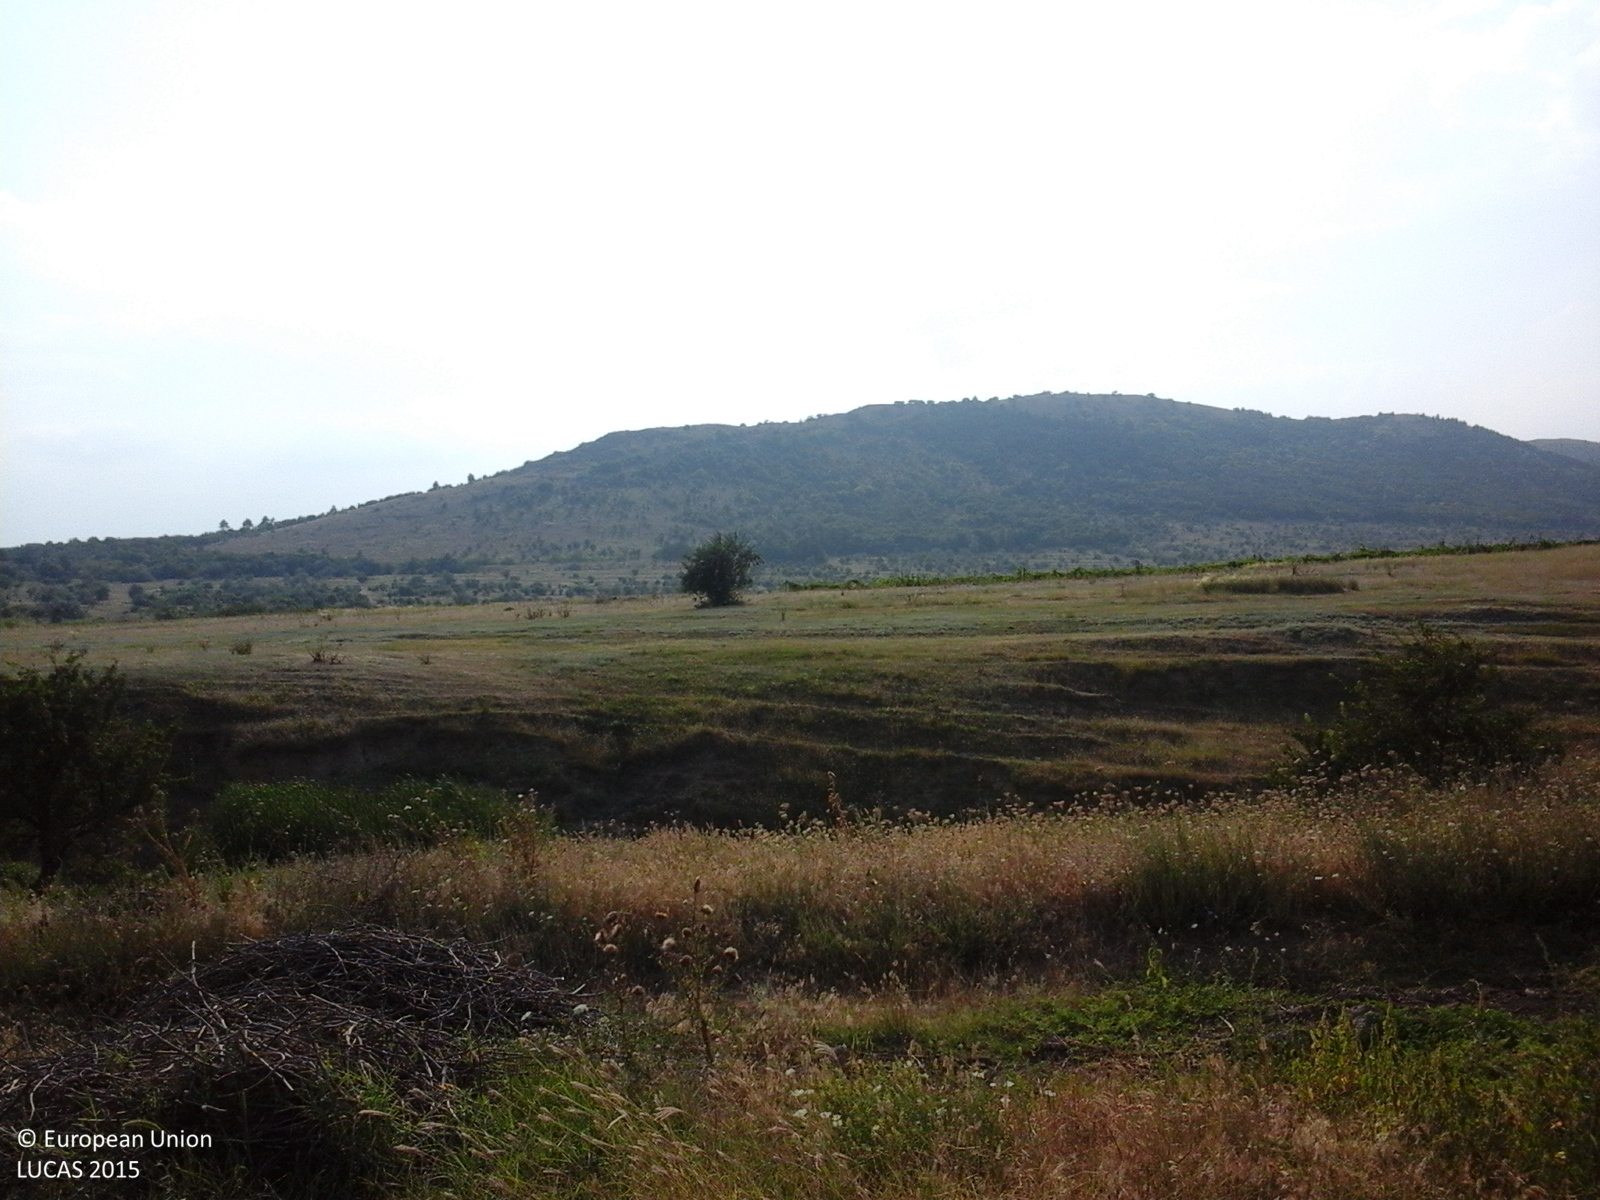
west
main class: Grassland
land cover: Grassland without tree/shrub cover
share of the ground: > 75 %
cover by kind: herbaceous plants 100 %
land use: Agriculture (excluding fallow land and kitchen gardens)
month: July
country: RO
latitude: 45.1080
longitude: 28.2852
